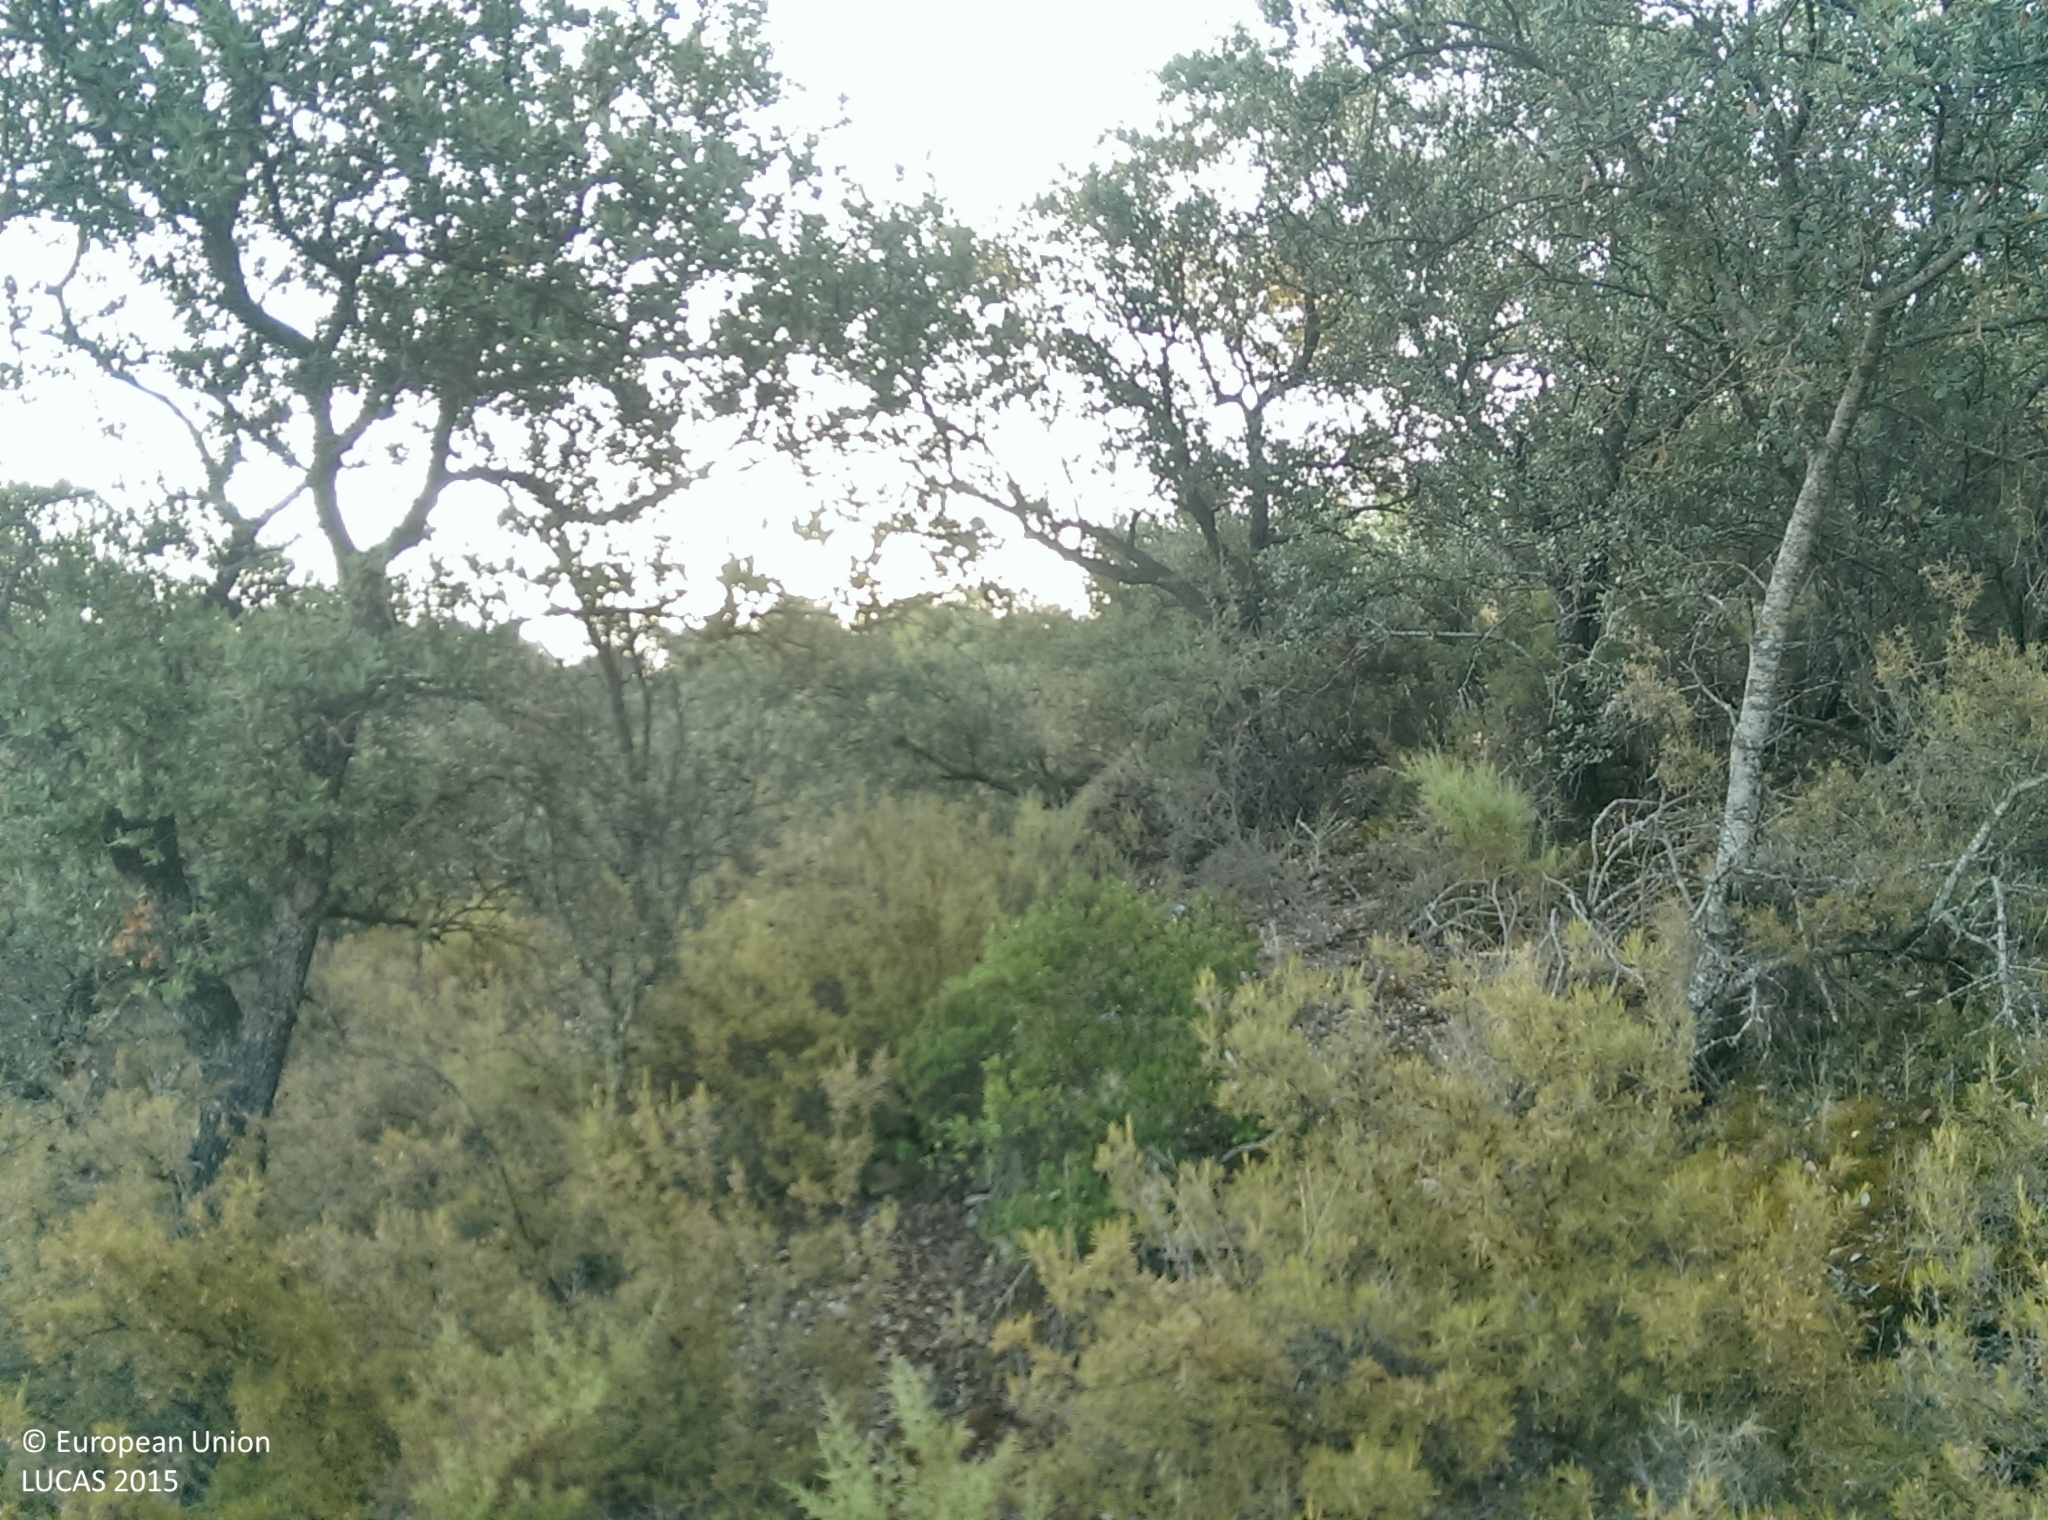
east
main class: Woodland
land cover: Broadleaved woodland
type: broadleaved evergreen forest
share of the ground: 50 - 75 %
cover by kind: broadleaved forest trees 60 %, shrubs 30 %, unconsolidated bare surface 10 %
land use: Semi-natural and natural areas not in use
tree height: < 5 m
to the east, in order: Broadleaved woodland; Tracks; Broadleaved woodland
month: August
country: ES
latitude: 37.2484
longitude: -3.6889
